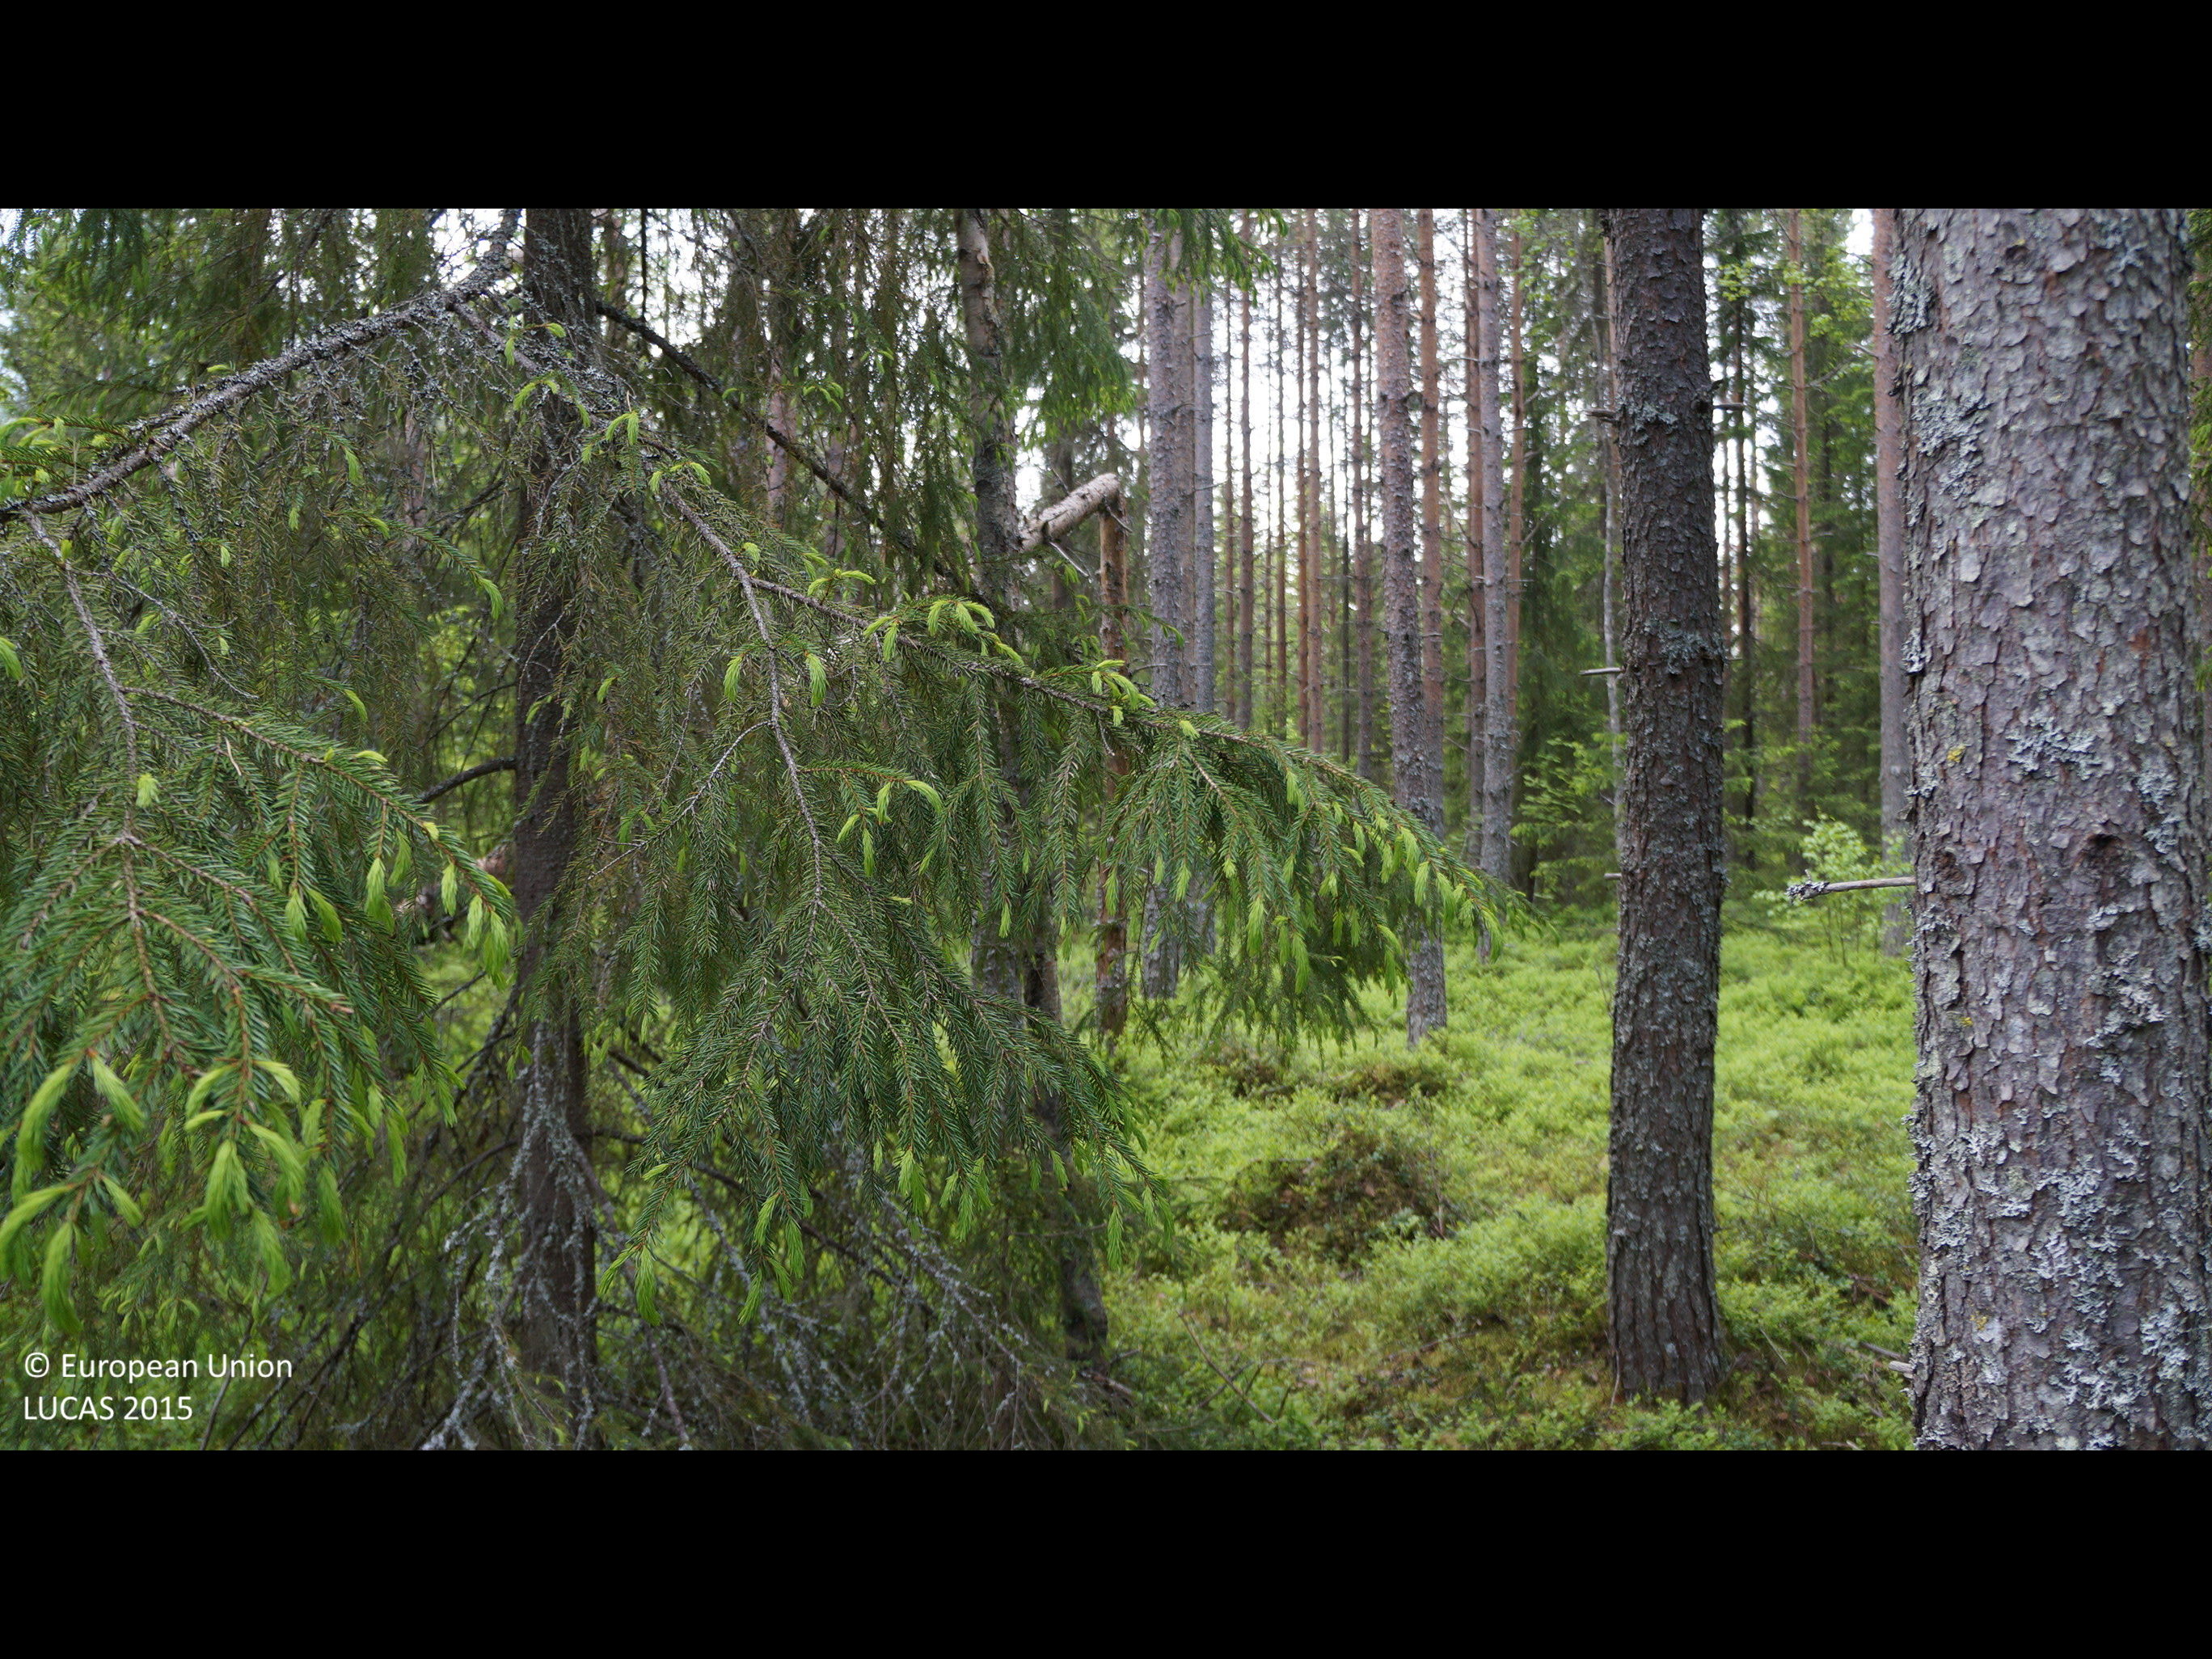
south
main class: Woodland
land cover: Pine dominated coniferous woodland
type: boreal forest
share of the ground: > 75 %
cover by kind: coniferous forest trees 70 %, shrubs 15 %, lichens and mosses 15 %
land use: Forestry
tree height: > 5 m
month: June
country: FI
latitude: 64.1720
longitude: 25.2500
